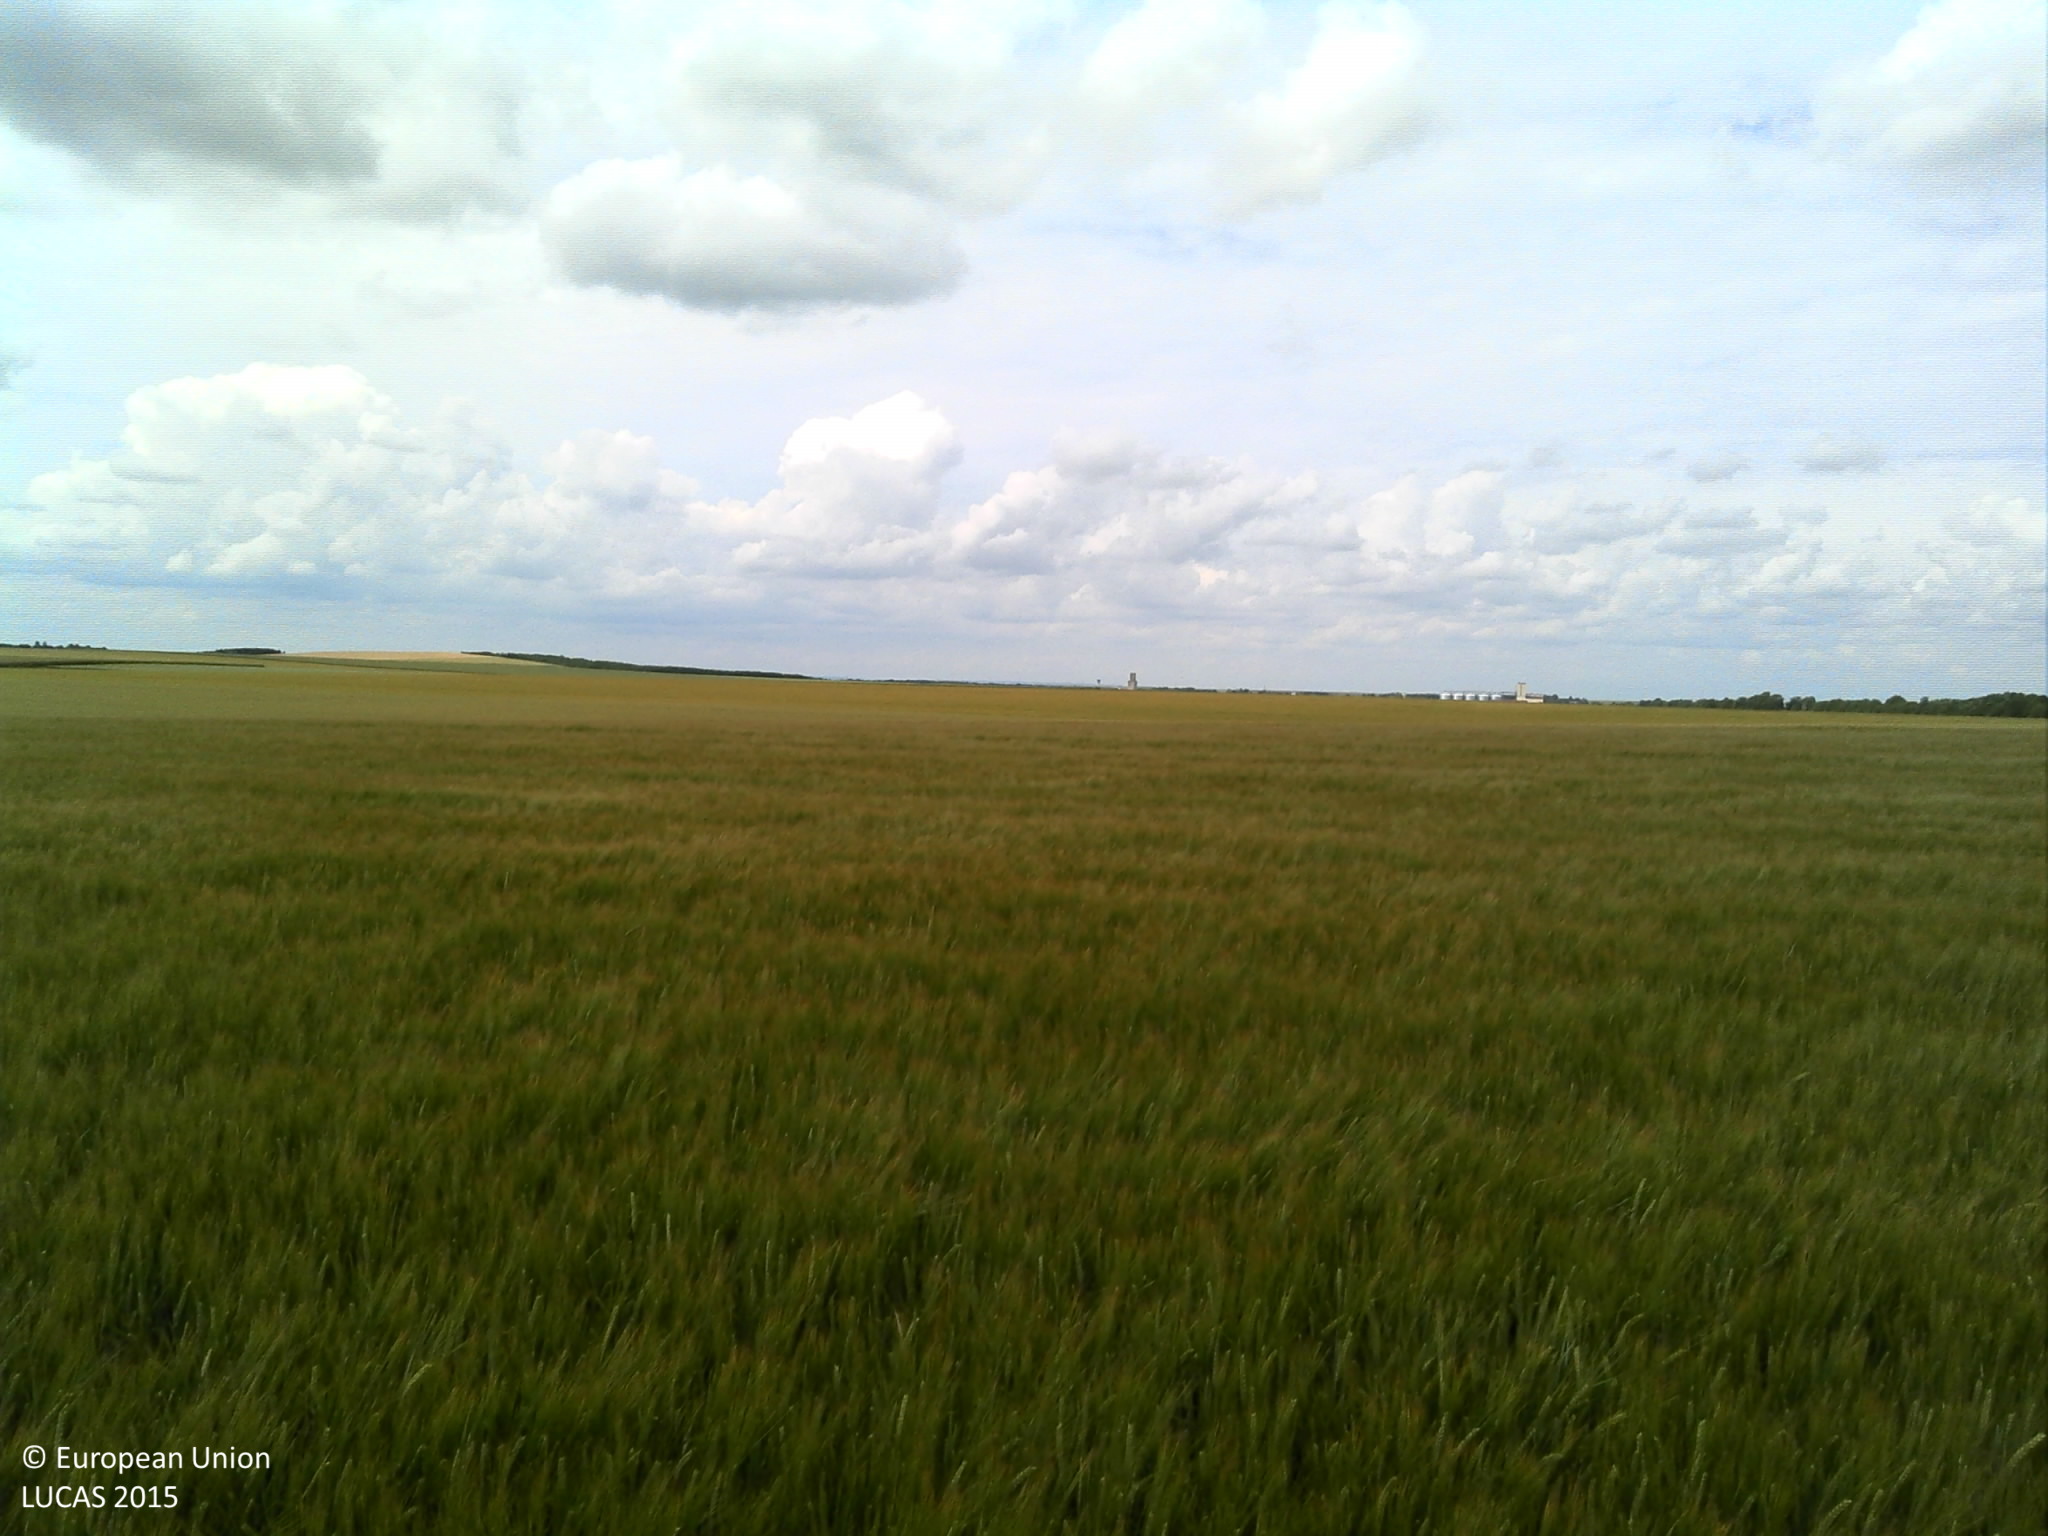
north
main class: Cropland
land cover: Barley
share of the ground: > 75 %
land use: Agriculture (excluding fallow land and kitchen gardens)
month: June
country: FR
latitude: 48.7019
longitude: 4.1941
